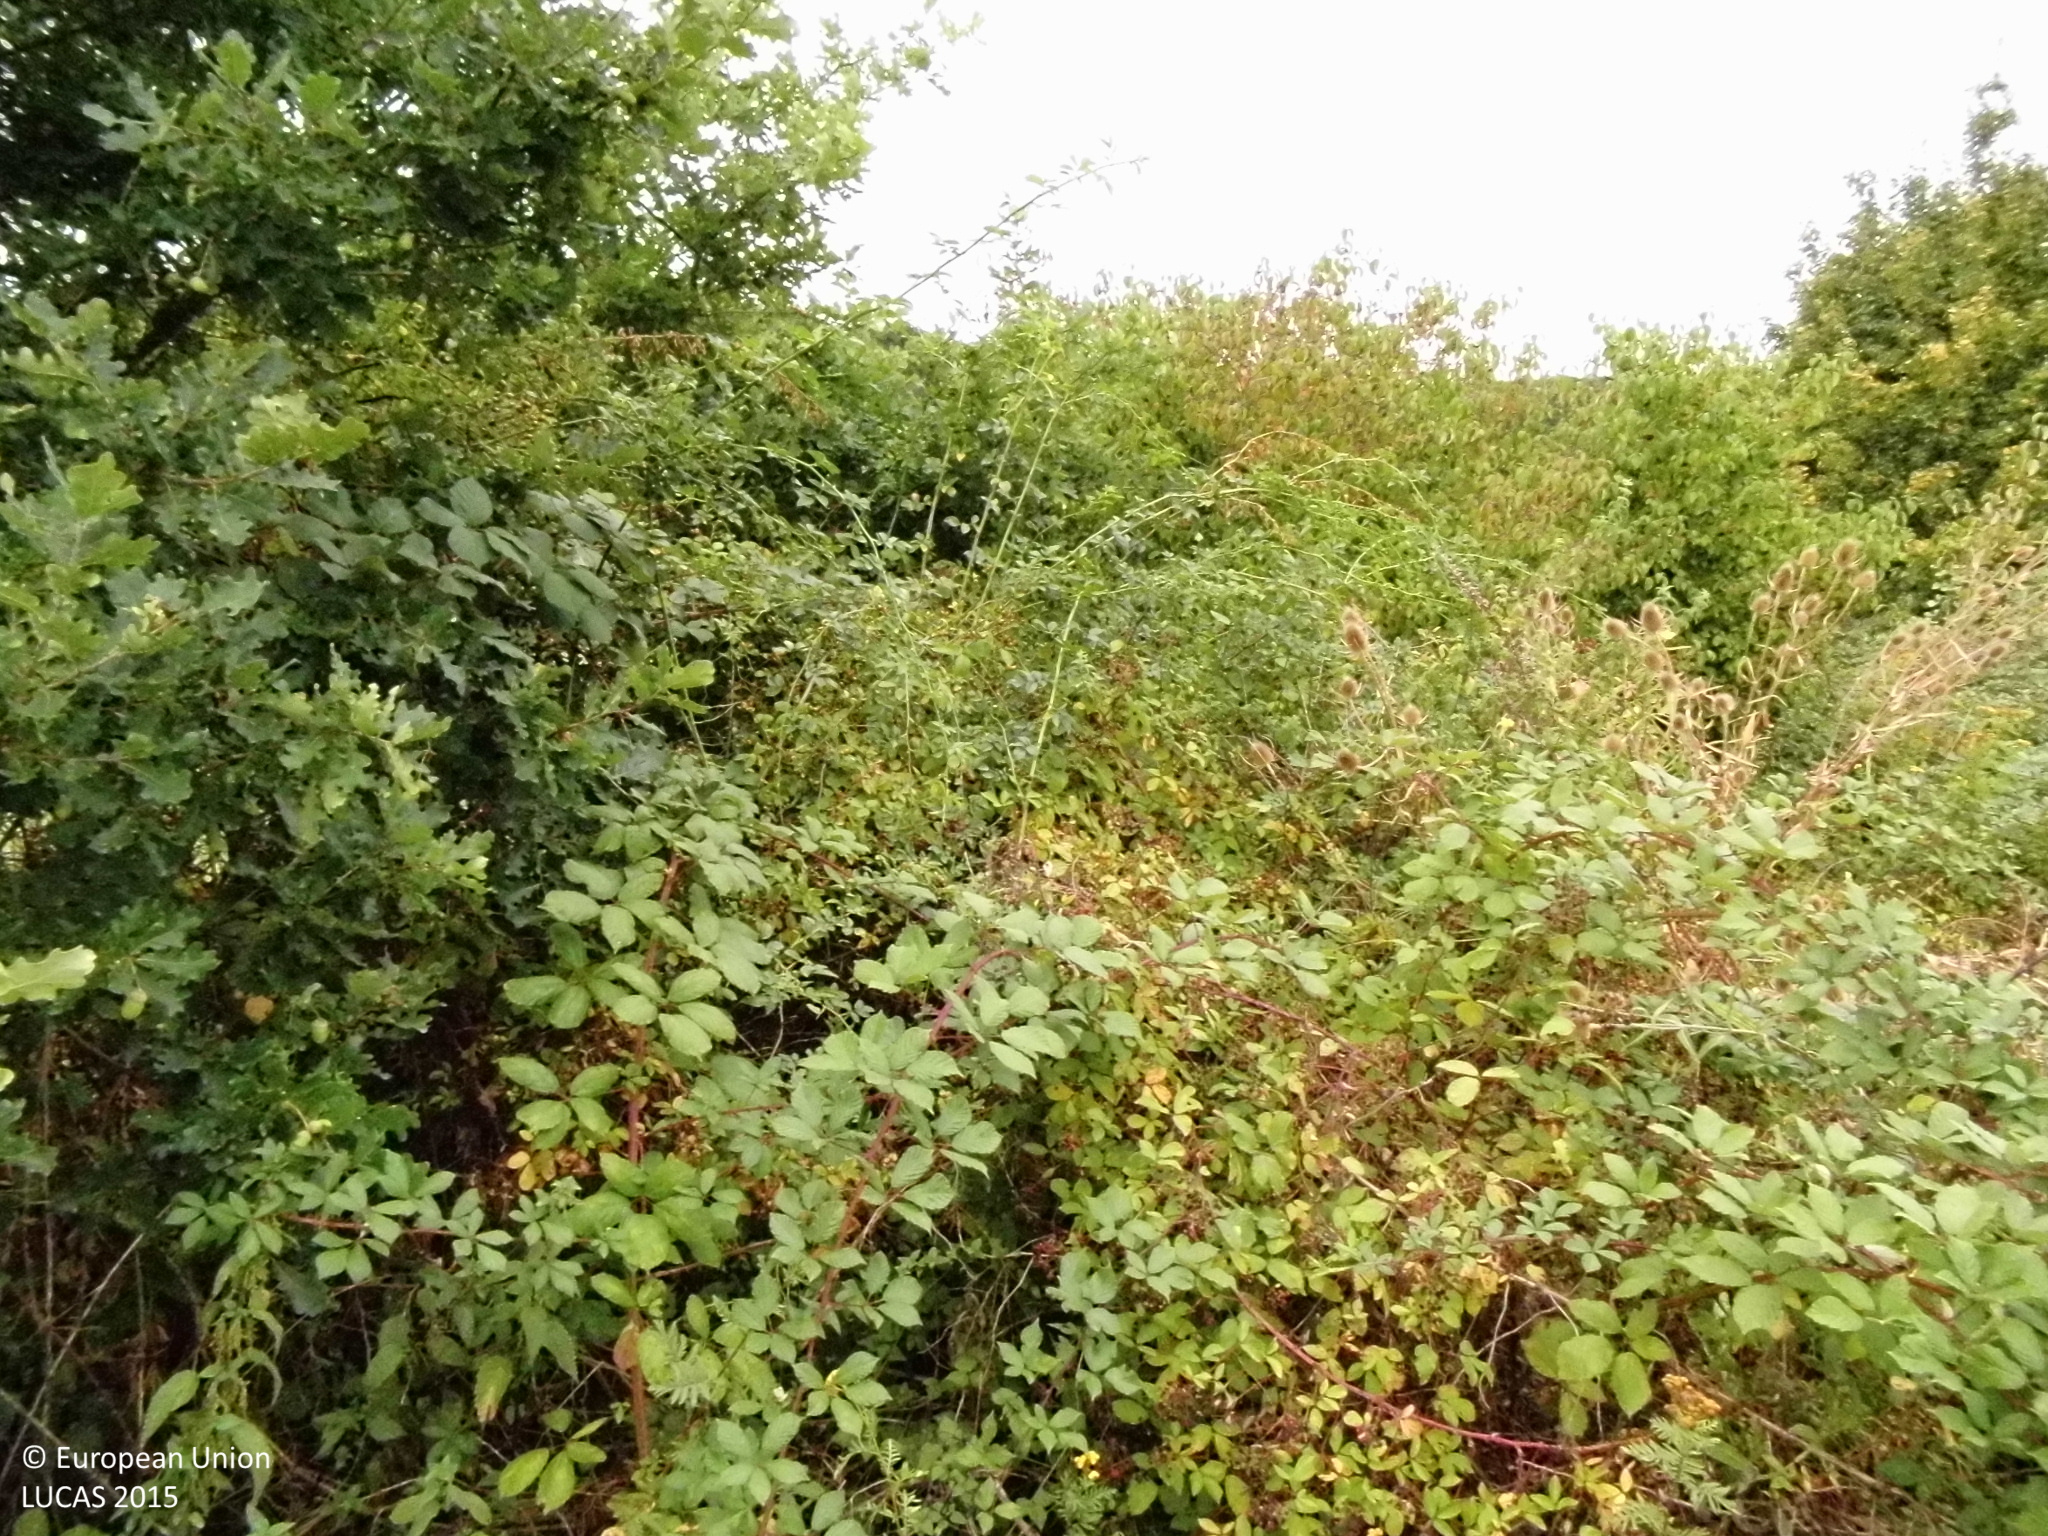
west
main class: Shrubland
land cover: Shrubland without tree cover
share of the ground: > 75 %
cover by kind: shrubs 90 %, herbaceous plants 10 %
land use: Semi-natural and natural areas not in use
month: August
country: DE
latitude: 50.4027
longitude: 8.1292
